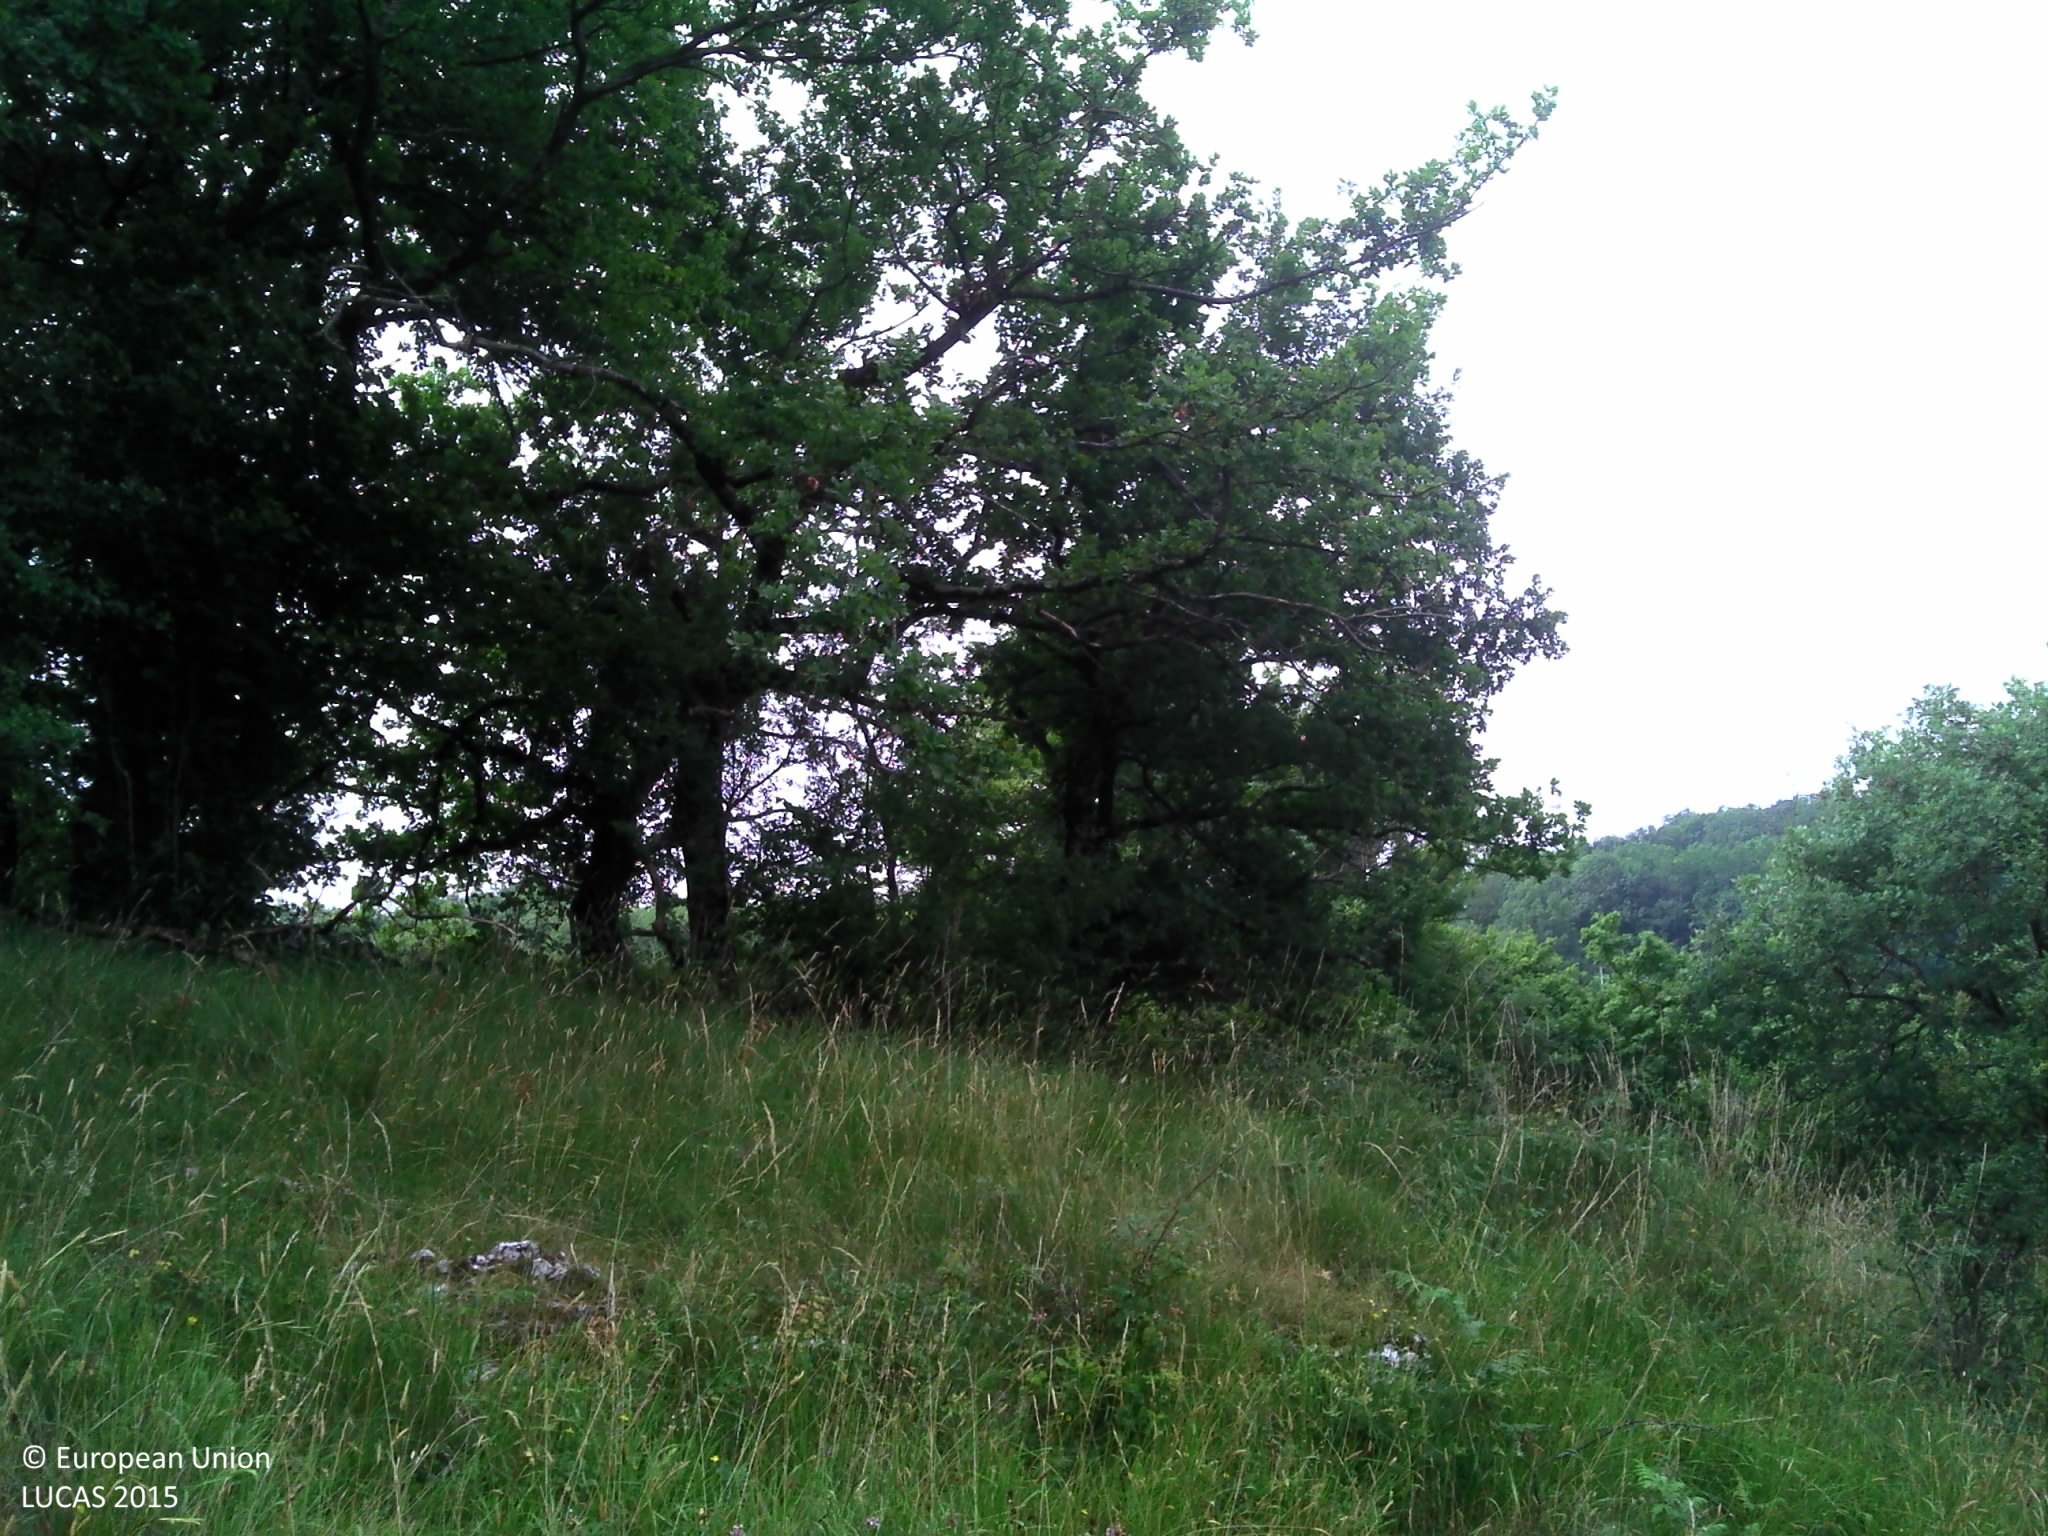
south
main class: Grassland
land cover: Grassland without tree/shrub cover
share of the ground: > 75 %
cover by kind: herbaceous plants 100 %
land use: Agriculture (excluding fallow land and kitchen gardens)
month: July
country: FR
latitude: 43.0222
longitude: 1.5022
